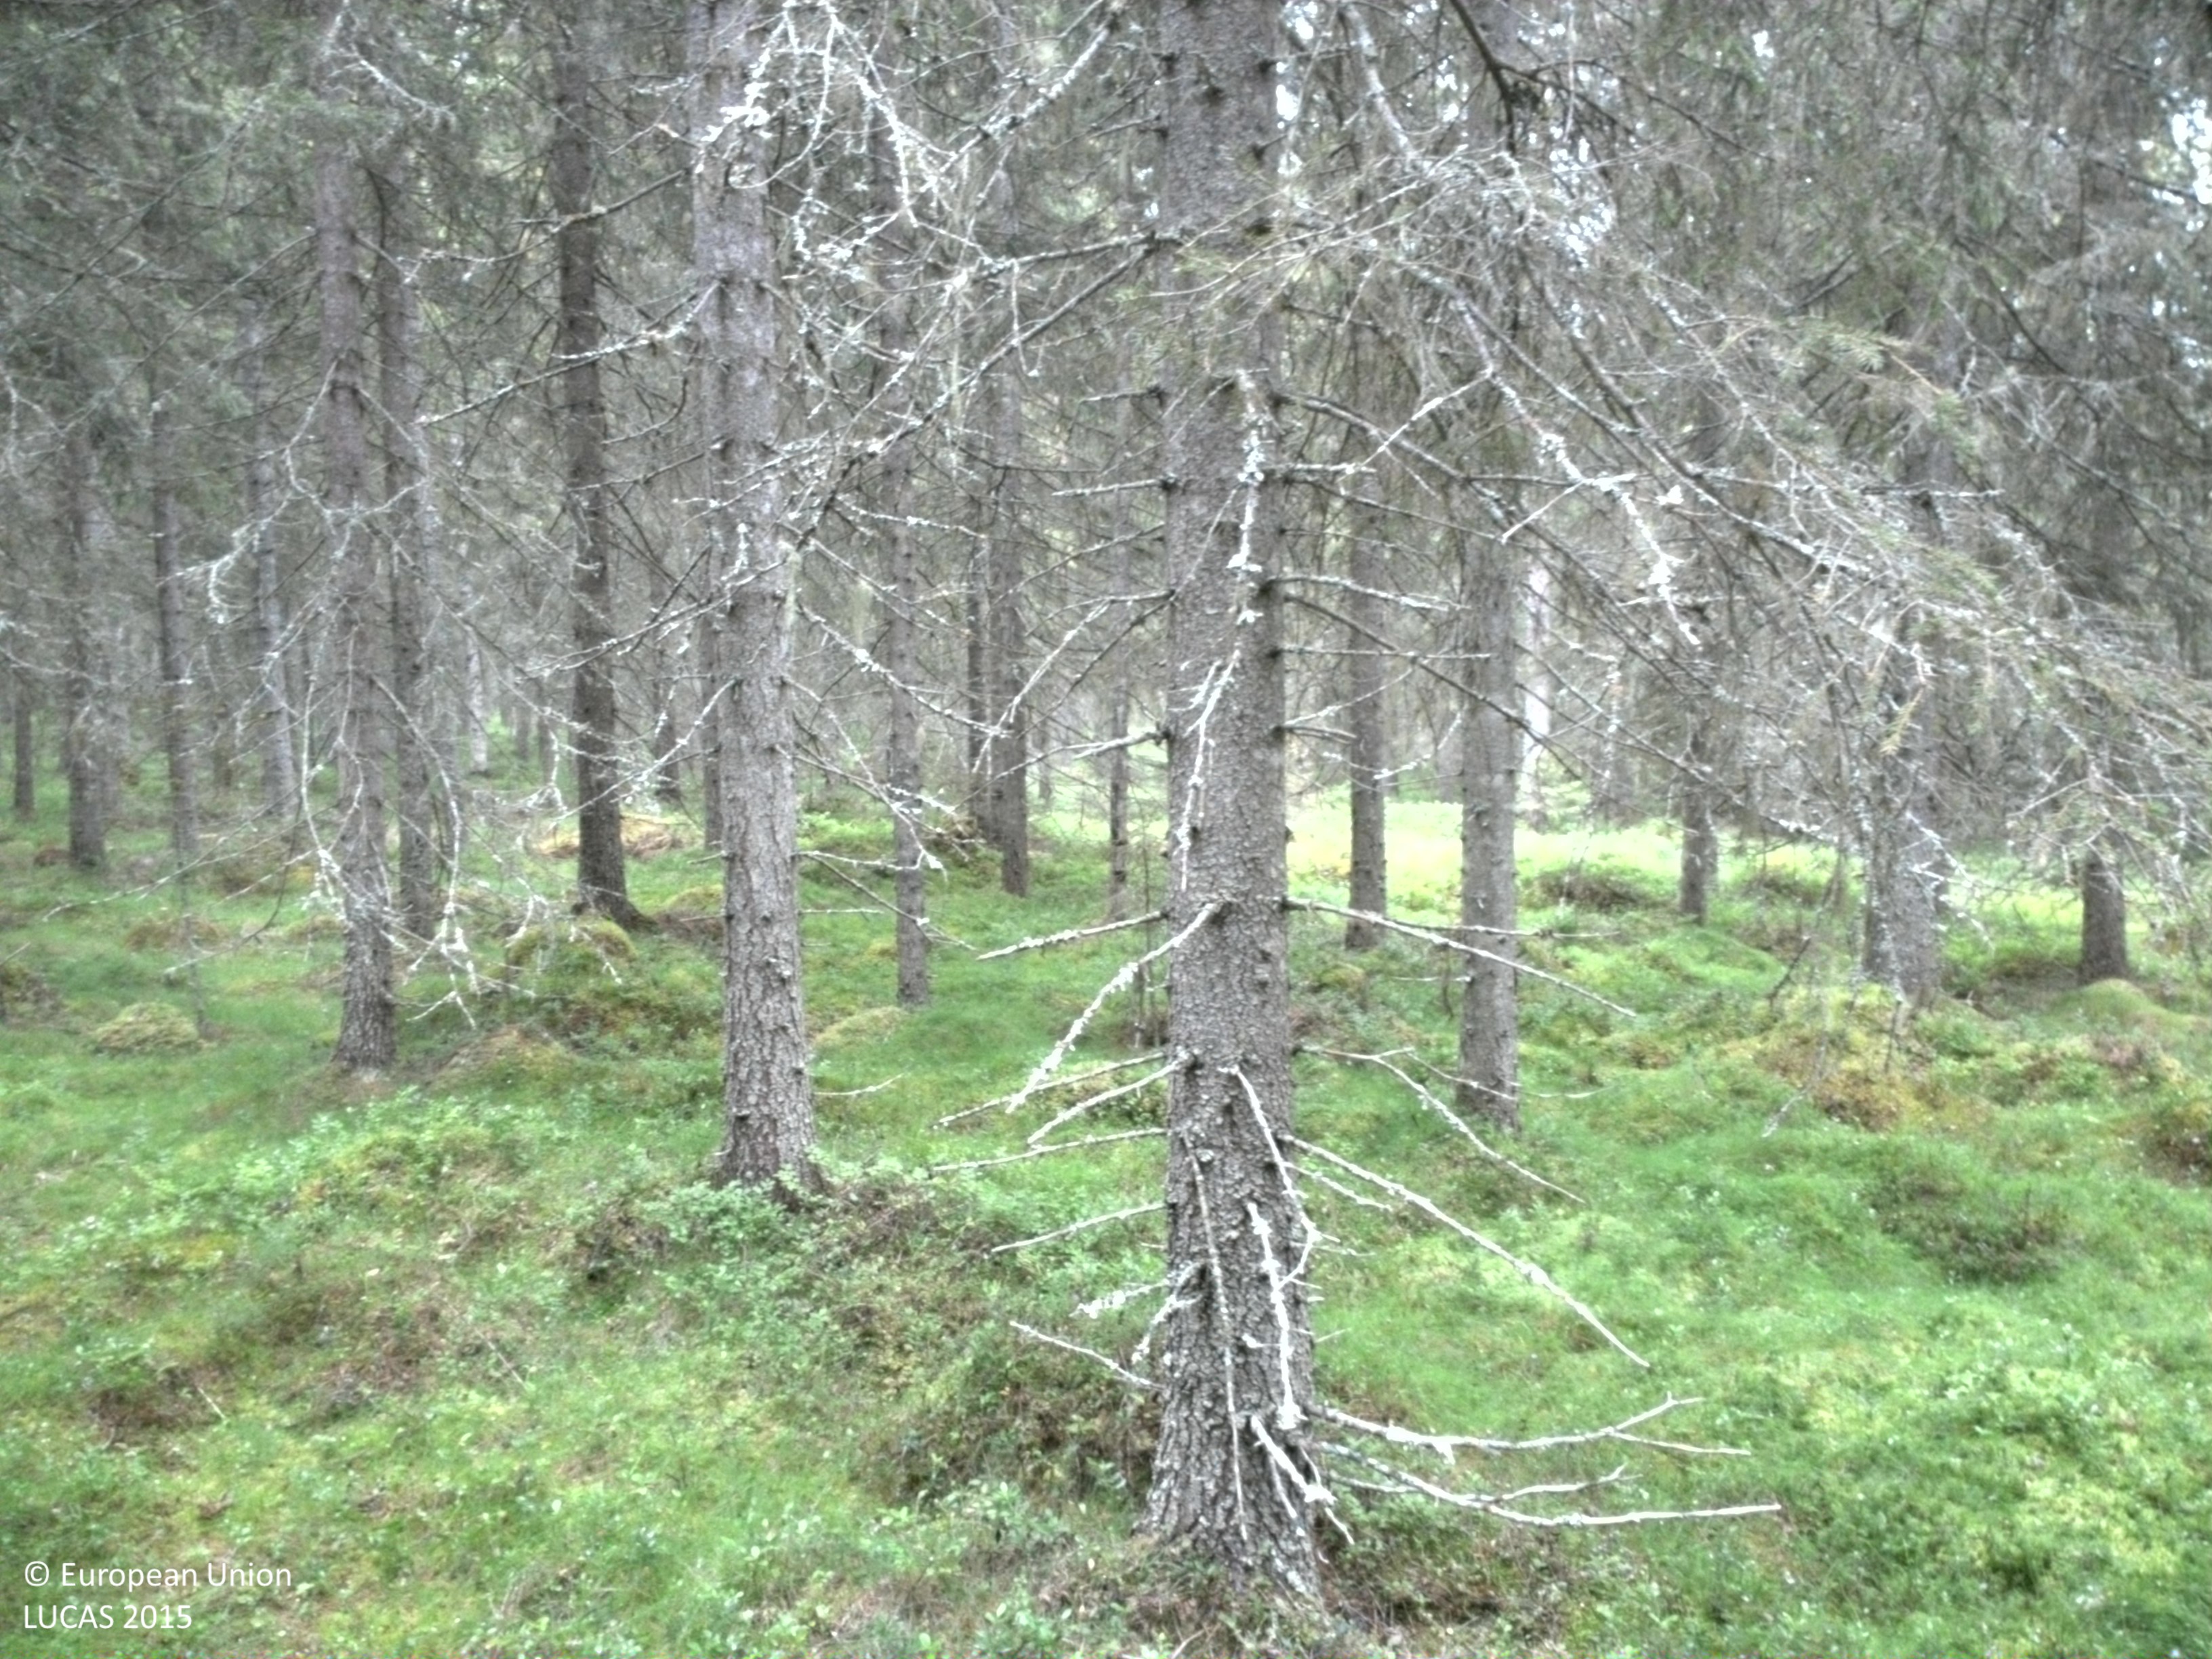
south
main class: Woodland
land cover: Spruce dominated coniferous woodland
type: boreal forest
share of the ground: 50 - 75 %
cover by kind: coniferous forest trees 70 %, herbaceous plants 15 %, shrubs 10 %, lichens and mosses 5 %
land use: Forestry
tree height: > 5 m
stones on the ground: > 50 %
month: August
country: SE
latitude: 64.6828
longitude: 20.0116
